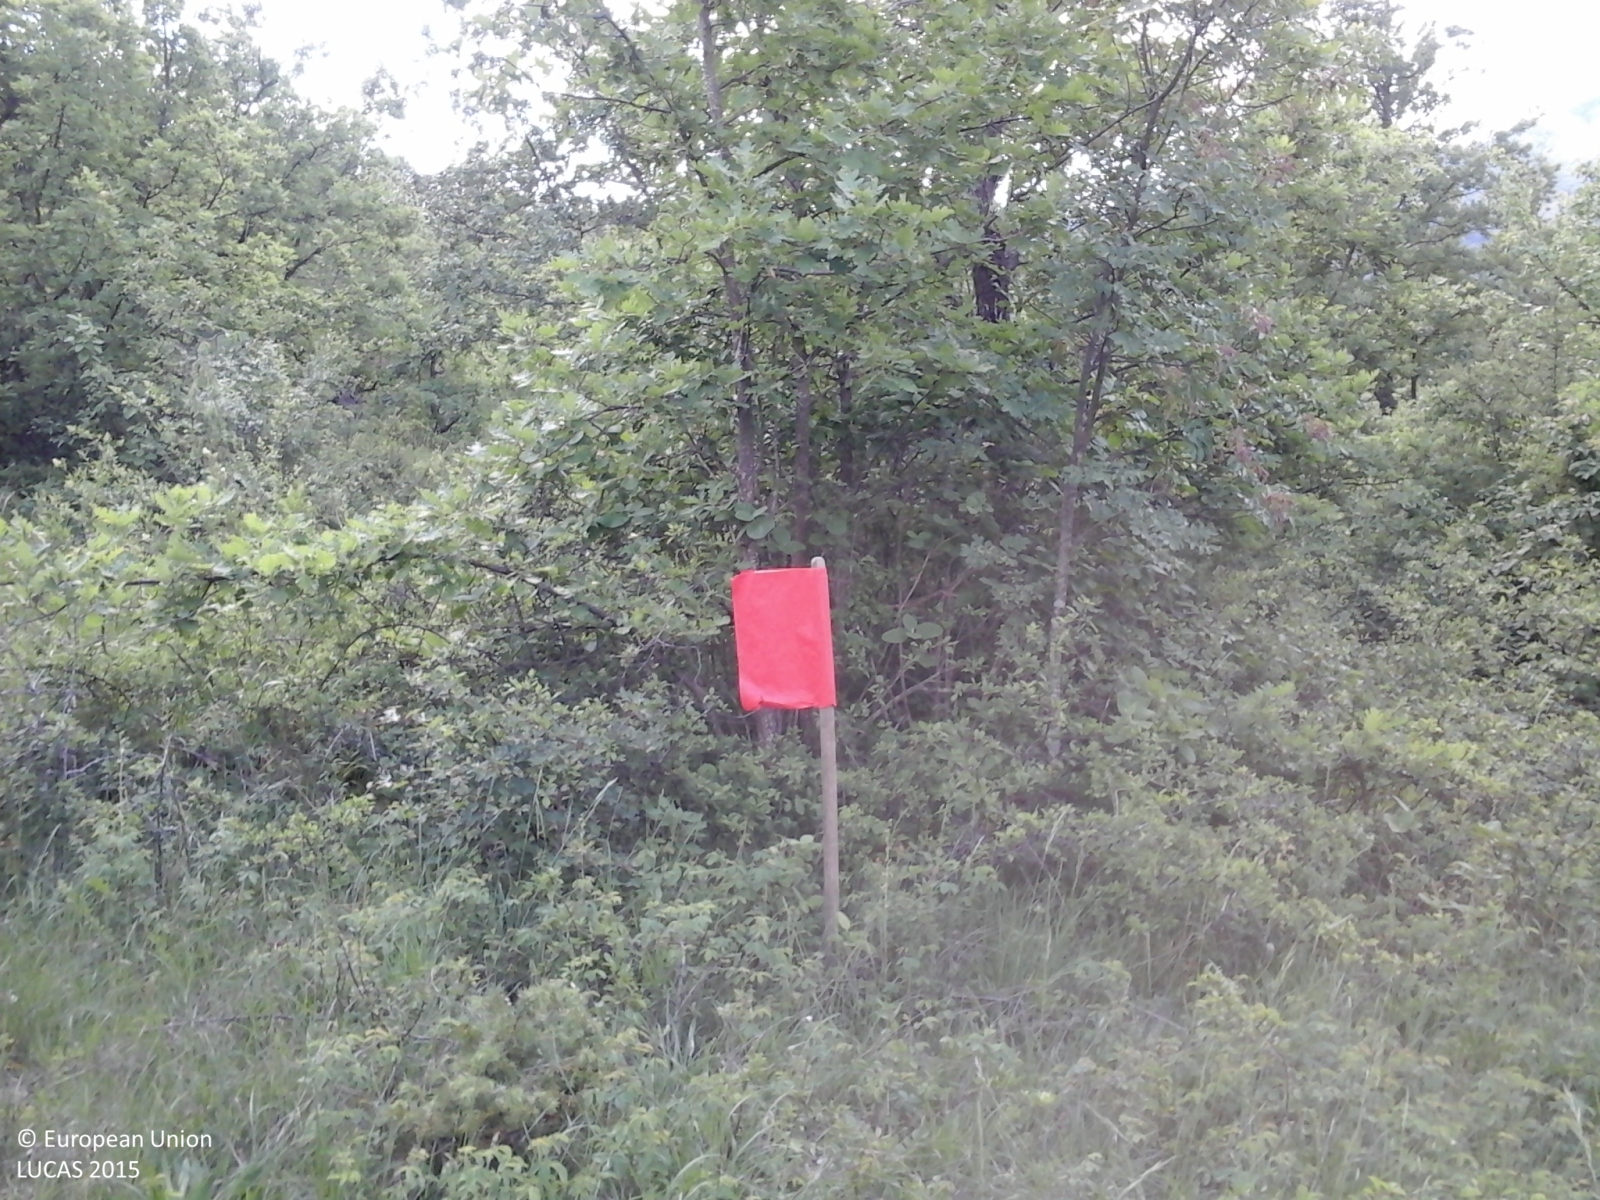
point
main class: Woodland
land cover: Broadleaved woodland
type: thermophilous deciduous forest
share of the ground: 50 - 75 %
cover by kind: broadleaved forest trees 70 %, shrubs 20 %, herbaceous plants 10 %
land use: Forestry
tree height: > 5 m
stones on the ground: < 10 %
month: May
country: IT
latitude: 44.6751
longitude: 9.8867
